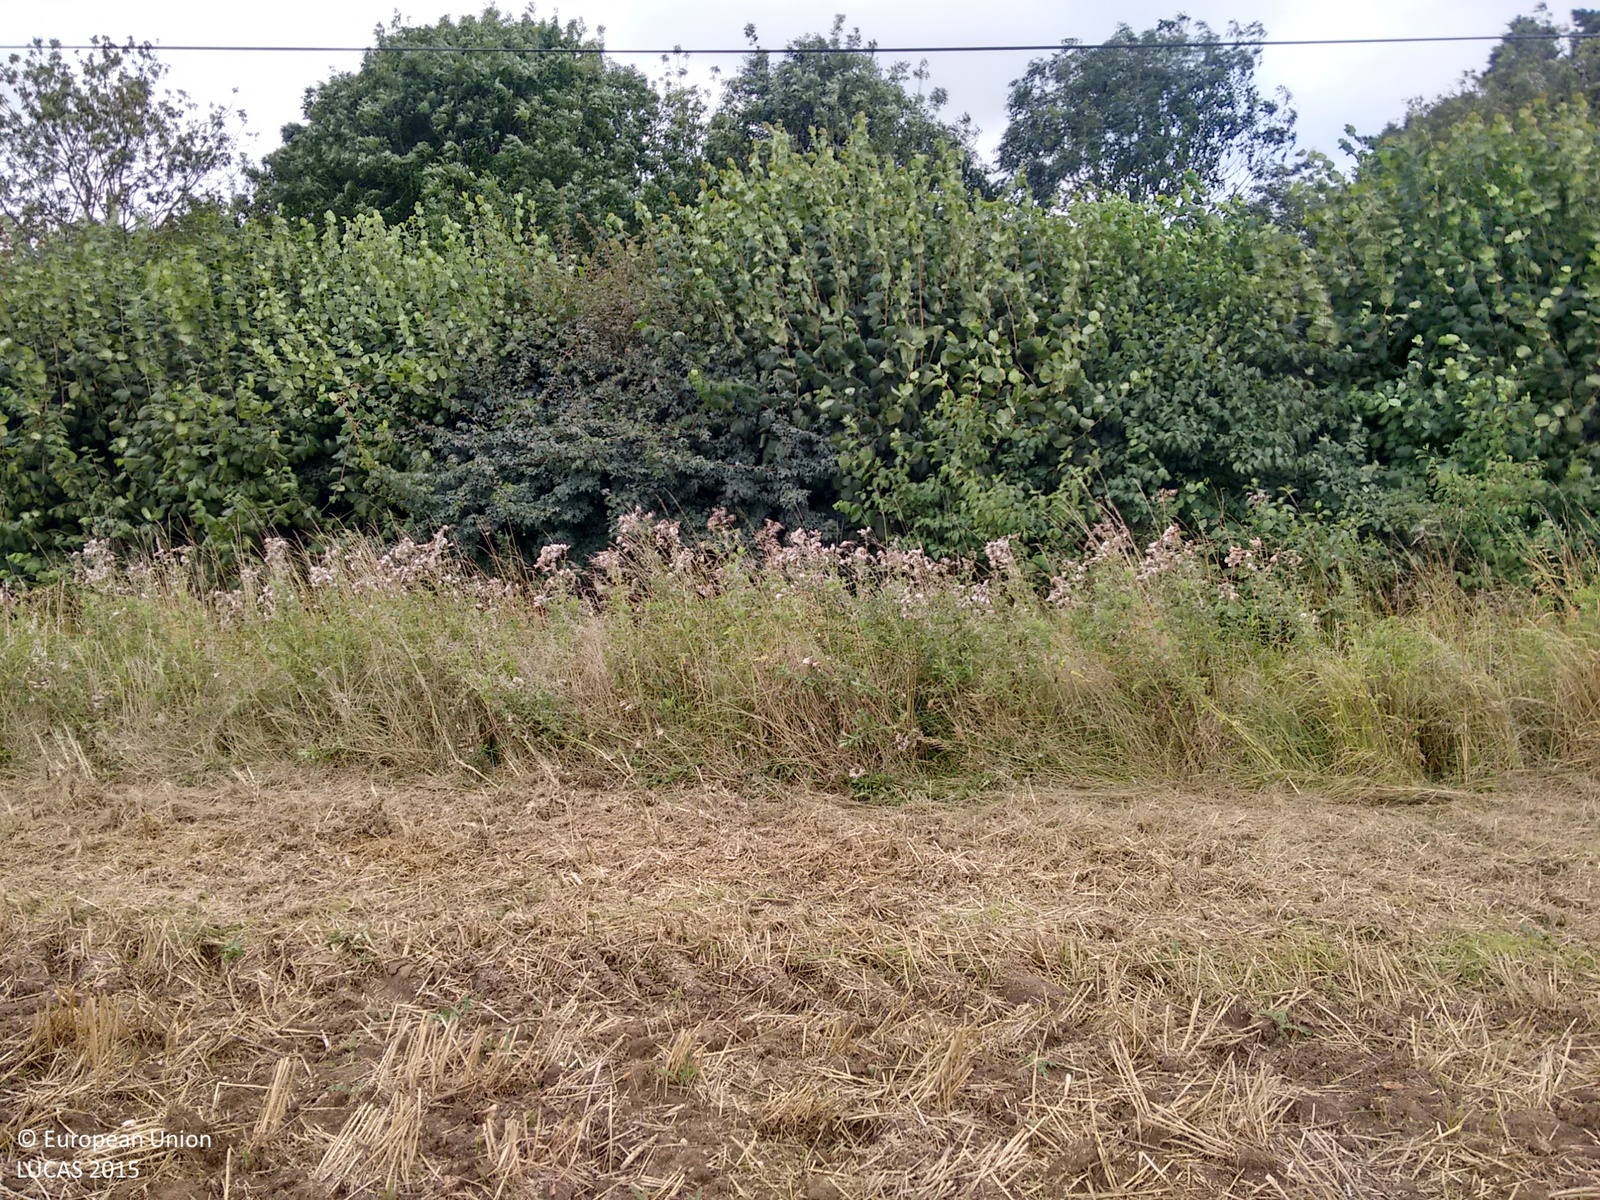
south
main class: Cropland
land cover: Common wheat
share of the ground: > 75 %
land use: Agriculture (excluding fallow land and kitchen gardens)
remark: Harvested field
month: September
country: GB
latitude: 52.2653
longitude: 0.9355
